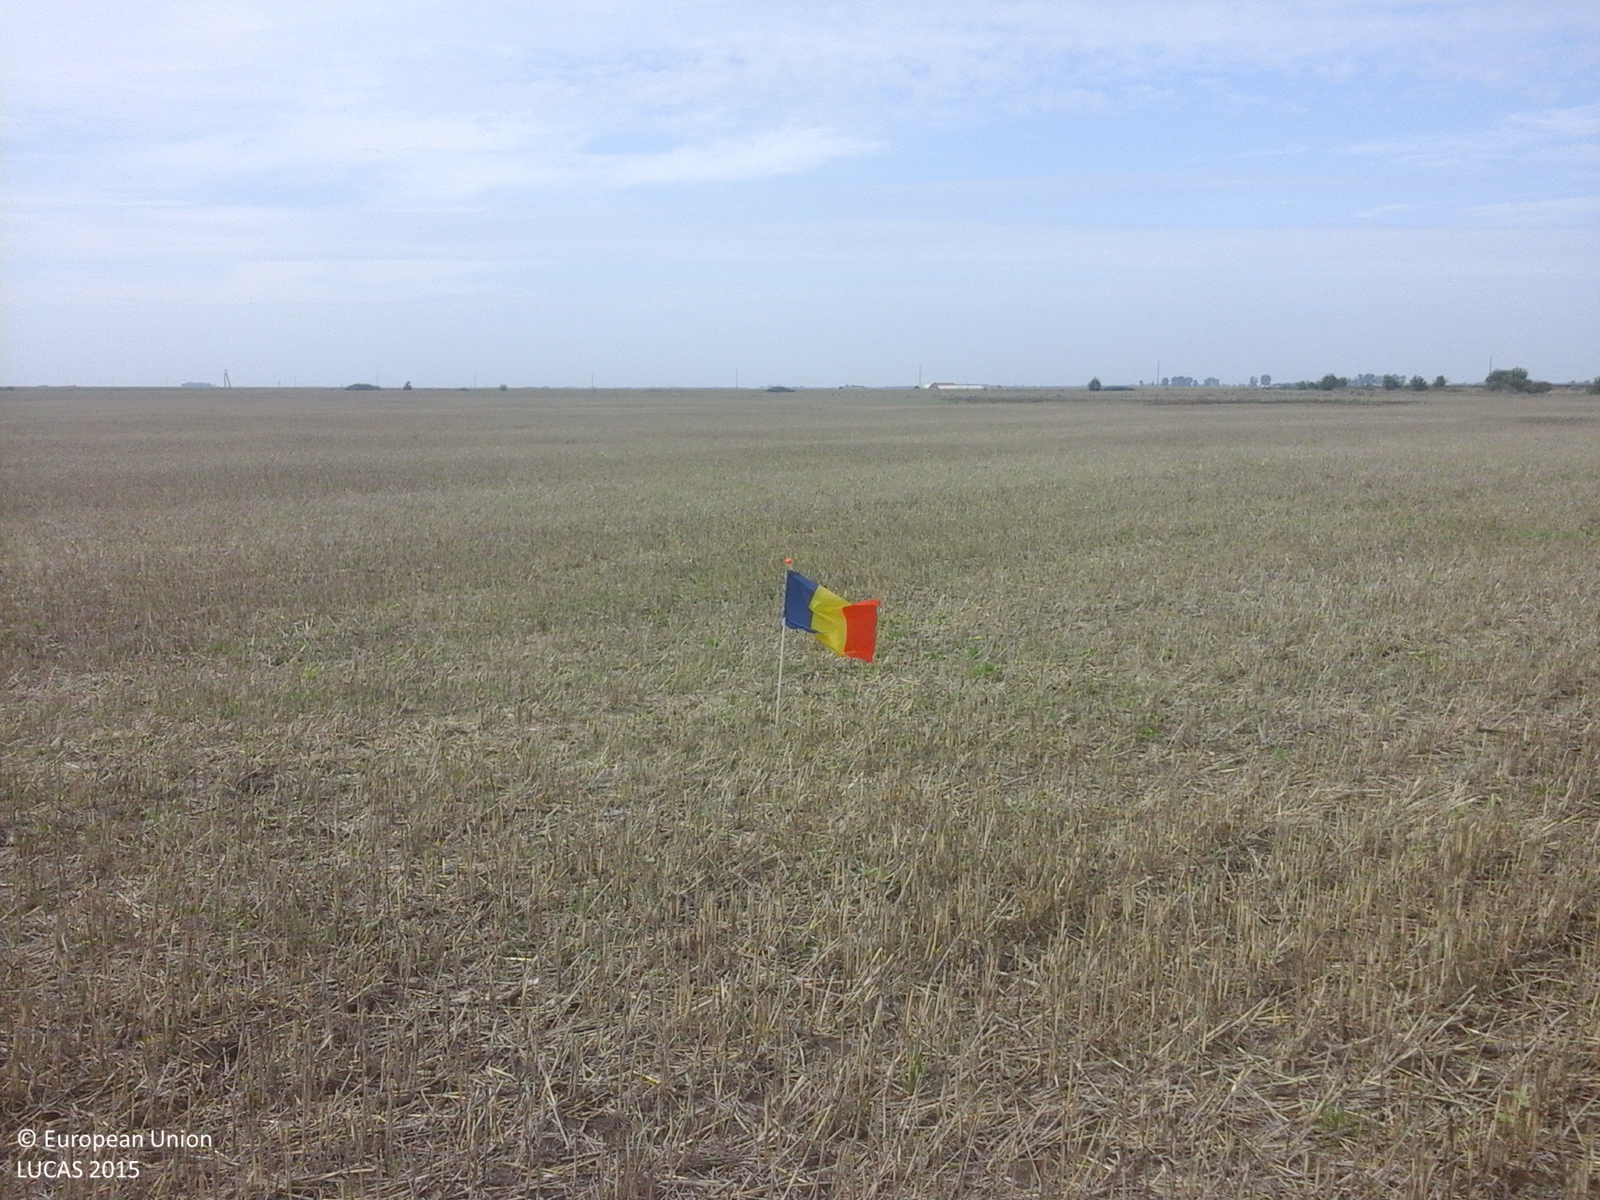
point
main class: Cropland
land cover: Common wheat
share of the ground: 50 - 75 %
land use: Agriculture (excluding fallow land and kitchen gardens)
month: August
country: RO
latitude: 46.4102
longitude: 21.4191
